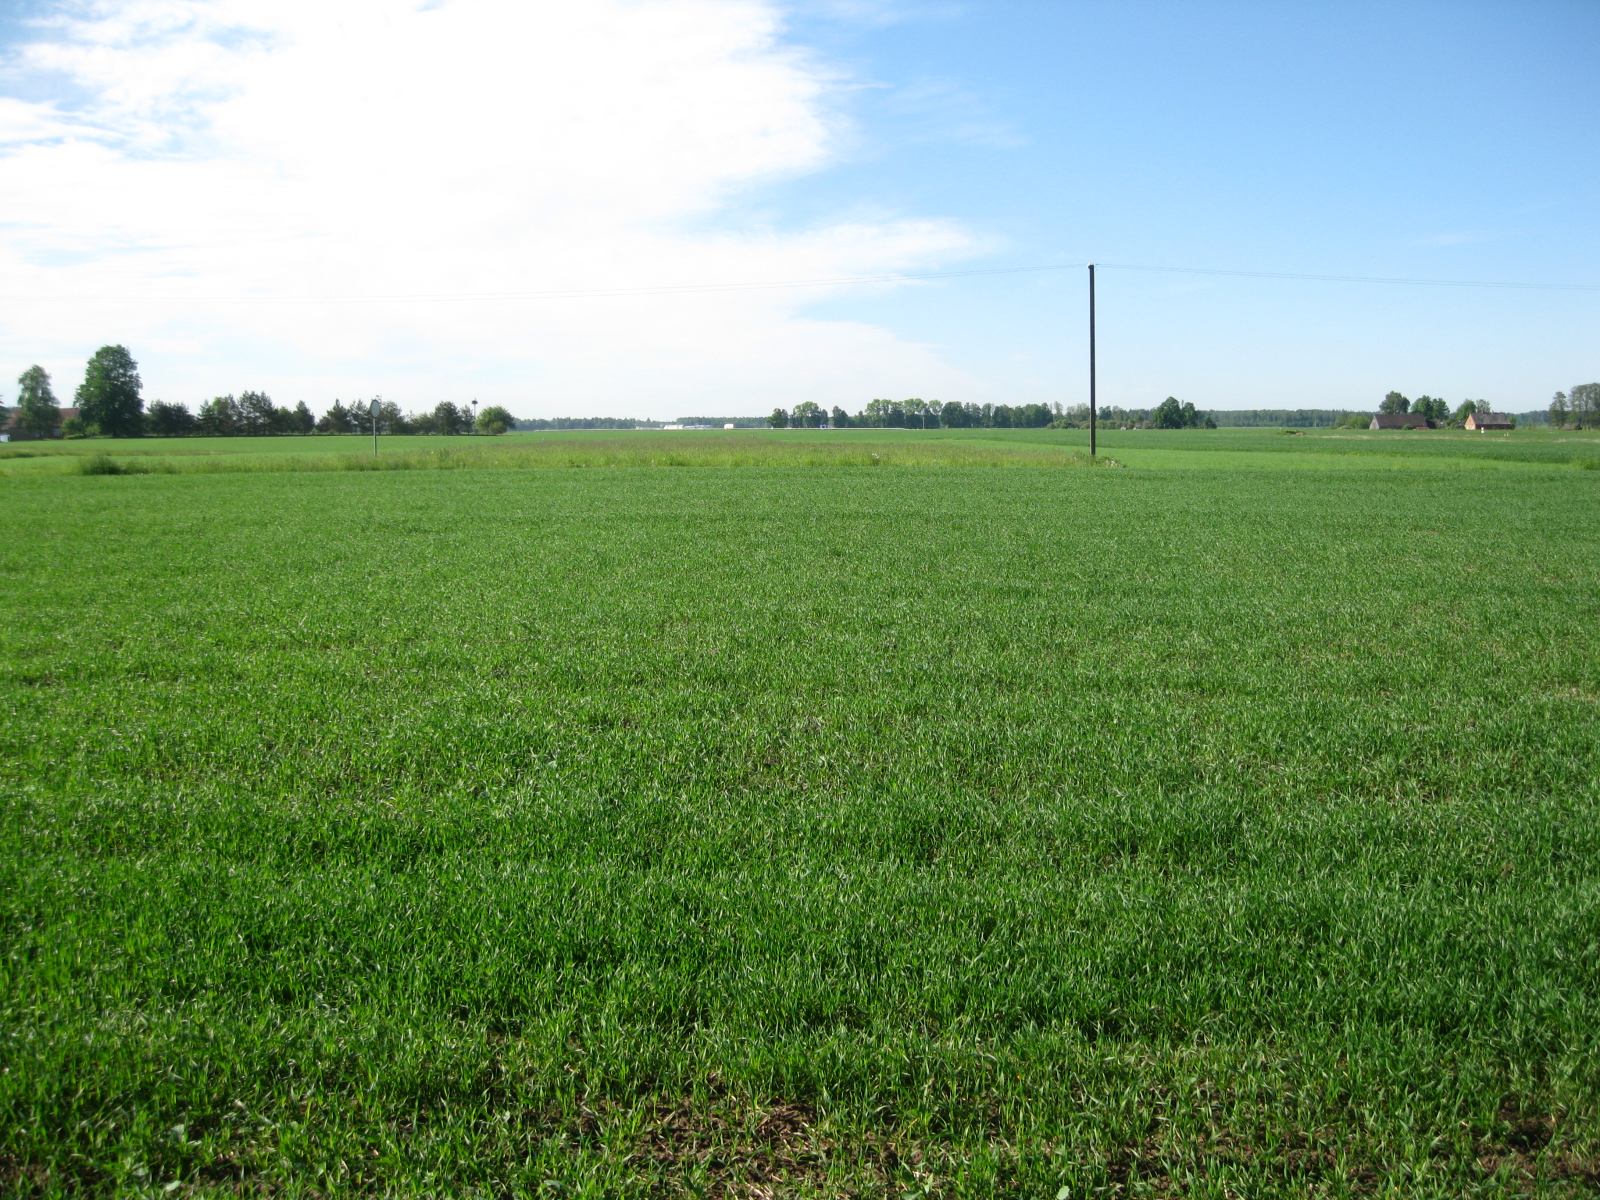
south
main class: Cropland
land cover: Common wheat
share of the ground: 50 - 75 %
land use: Agriculture (excluding fallow land and kitchen gardens)
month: May
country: LT
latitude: 55.8499
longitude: 24.3593
